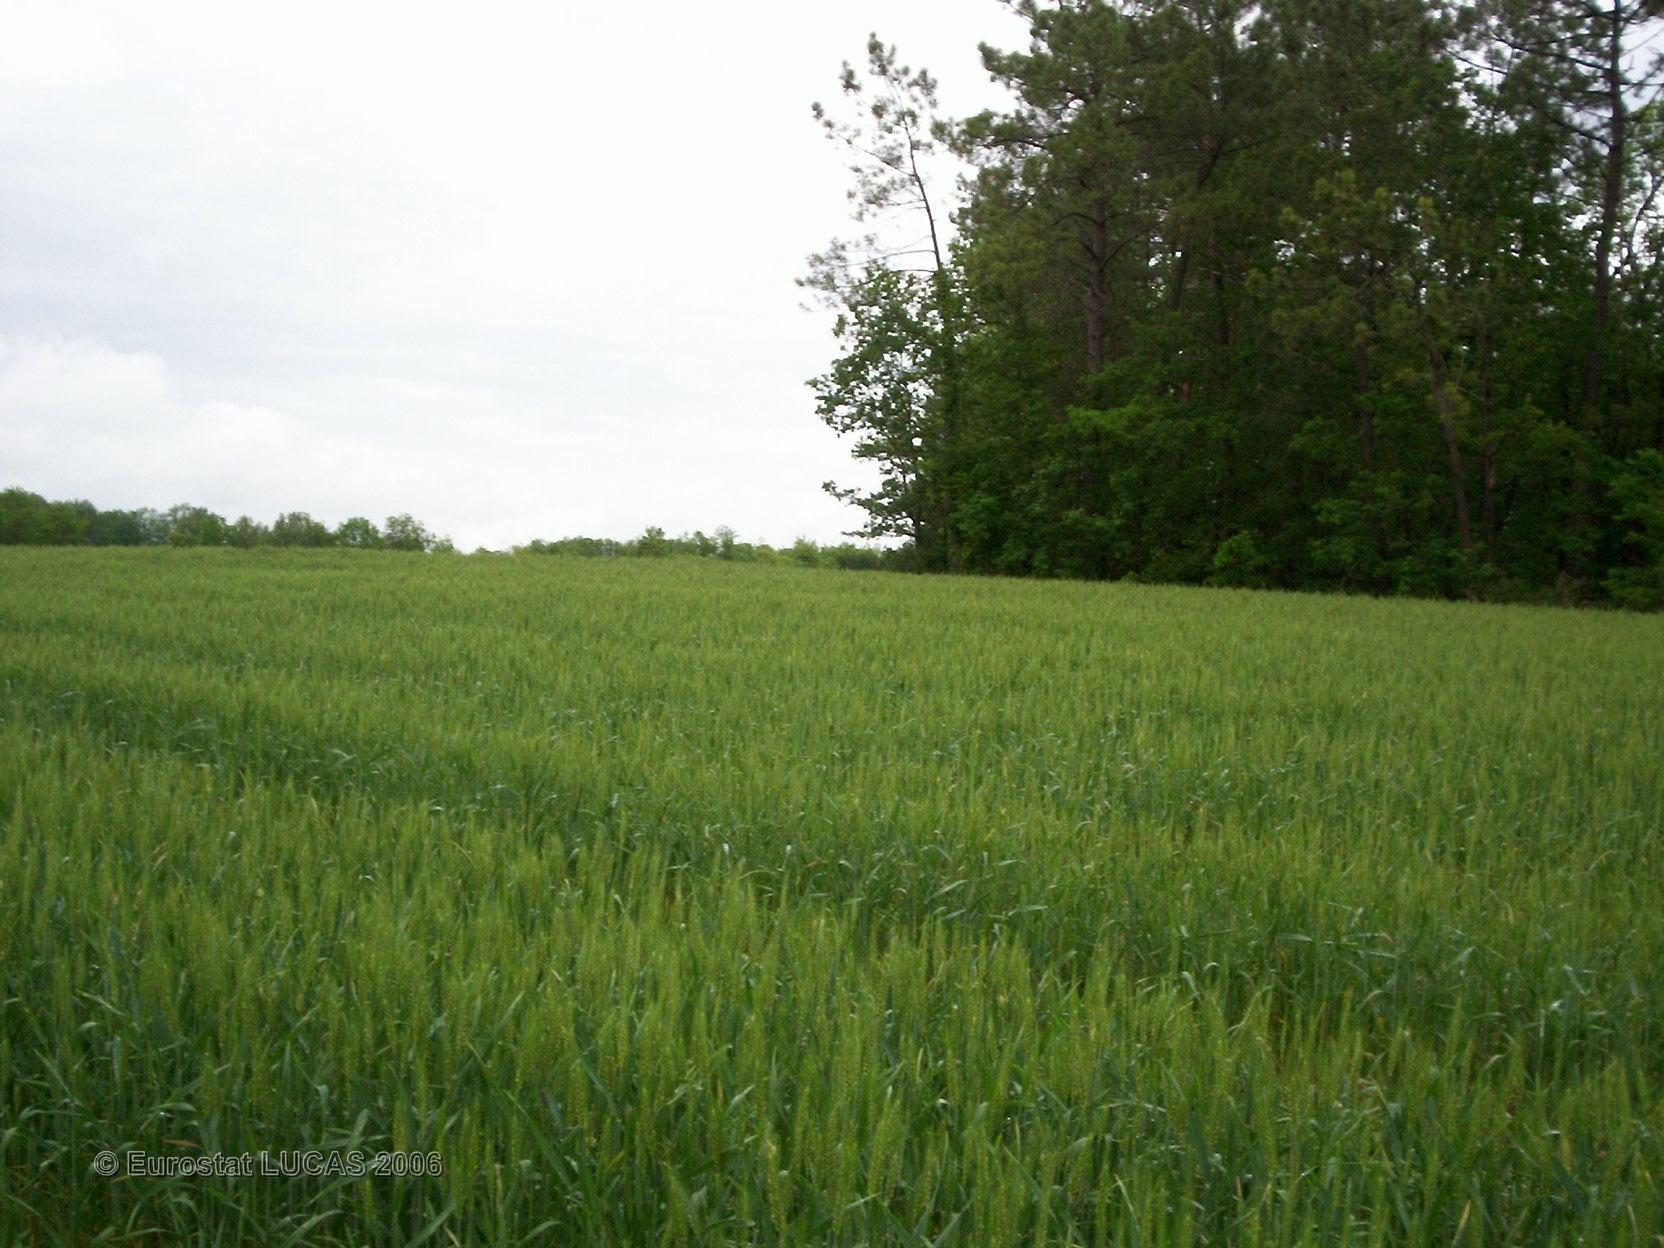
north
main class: Cropland
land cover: Triticale
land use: Agriculture (excluding fallow land and kitchen gardens)
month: May
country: FR
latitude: 45.3879
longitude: 0.5492
